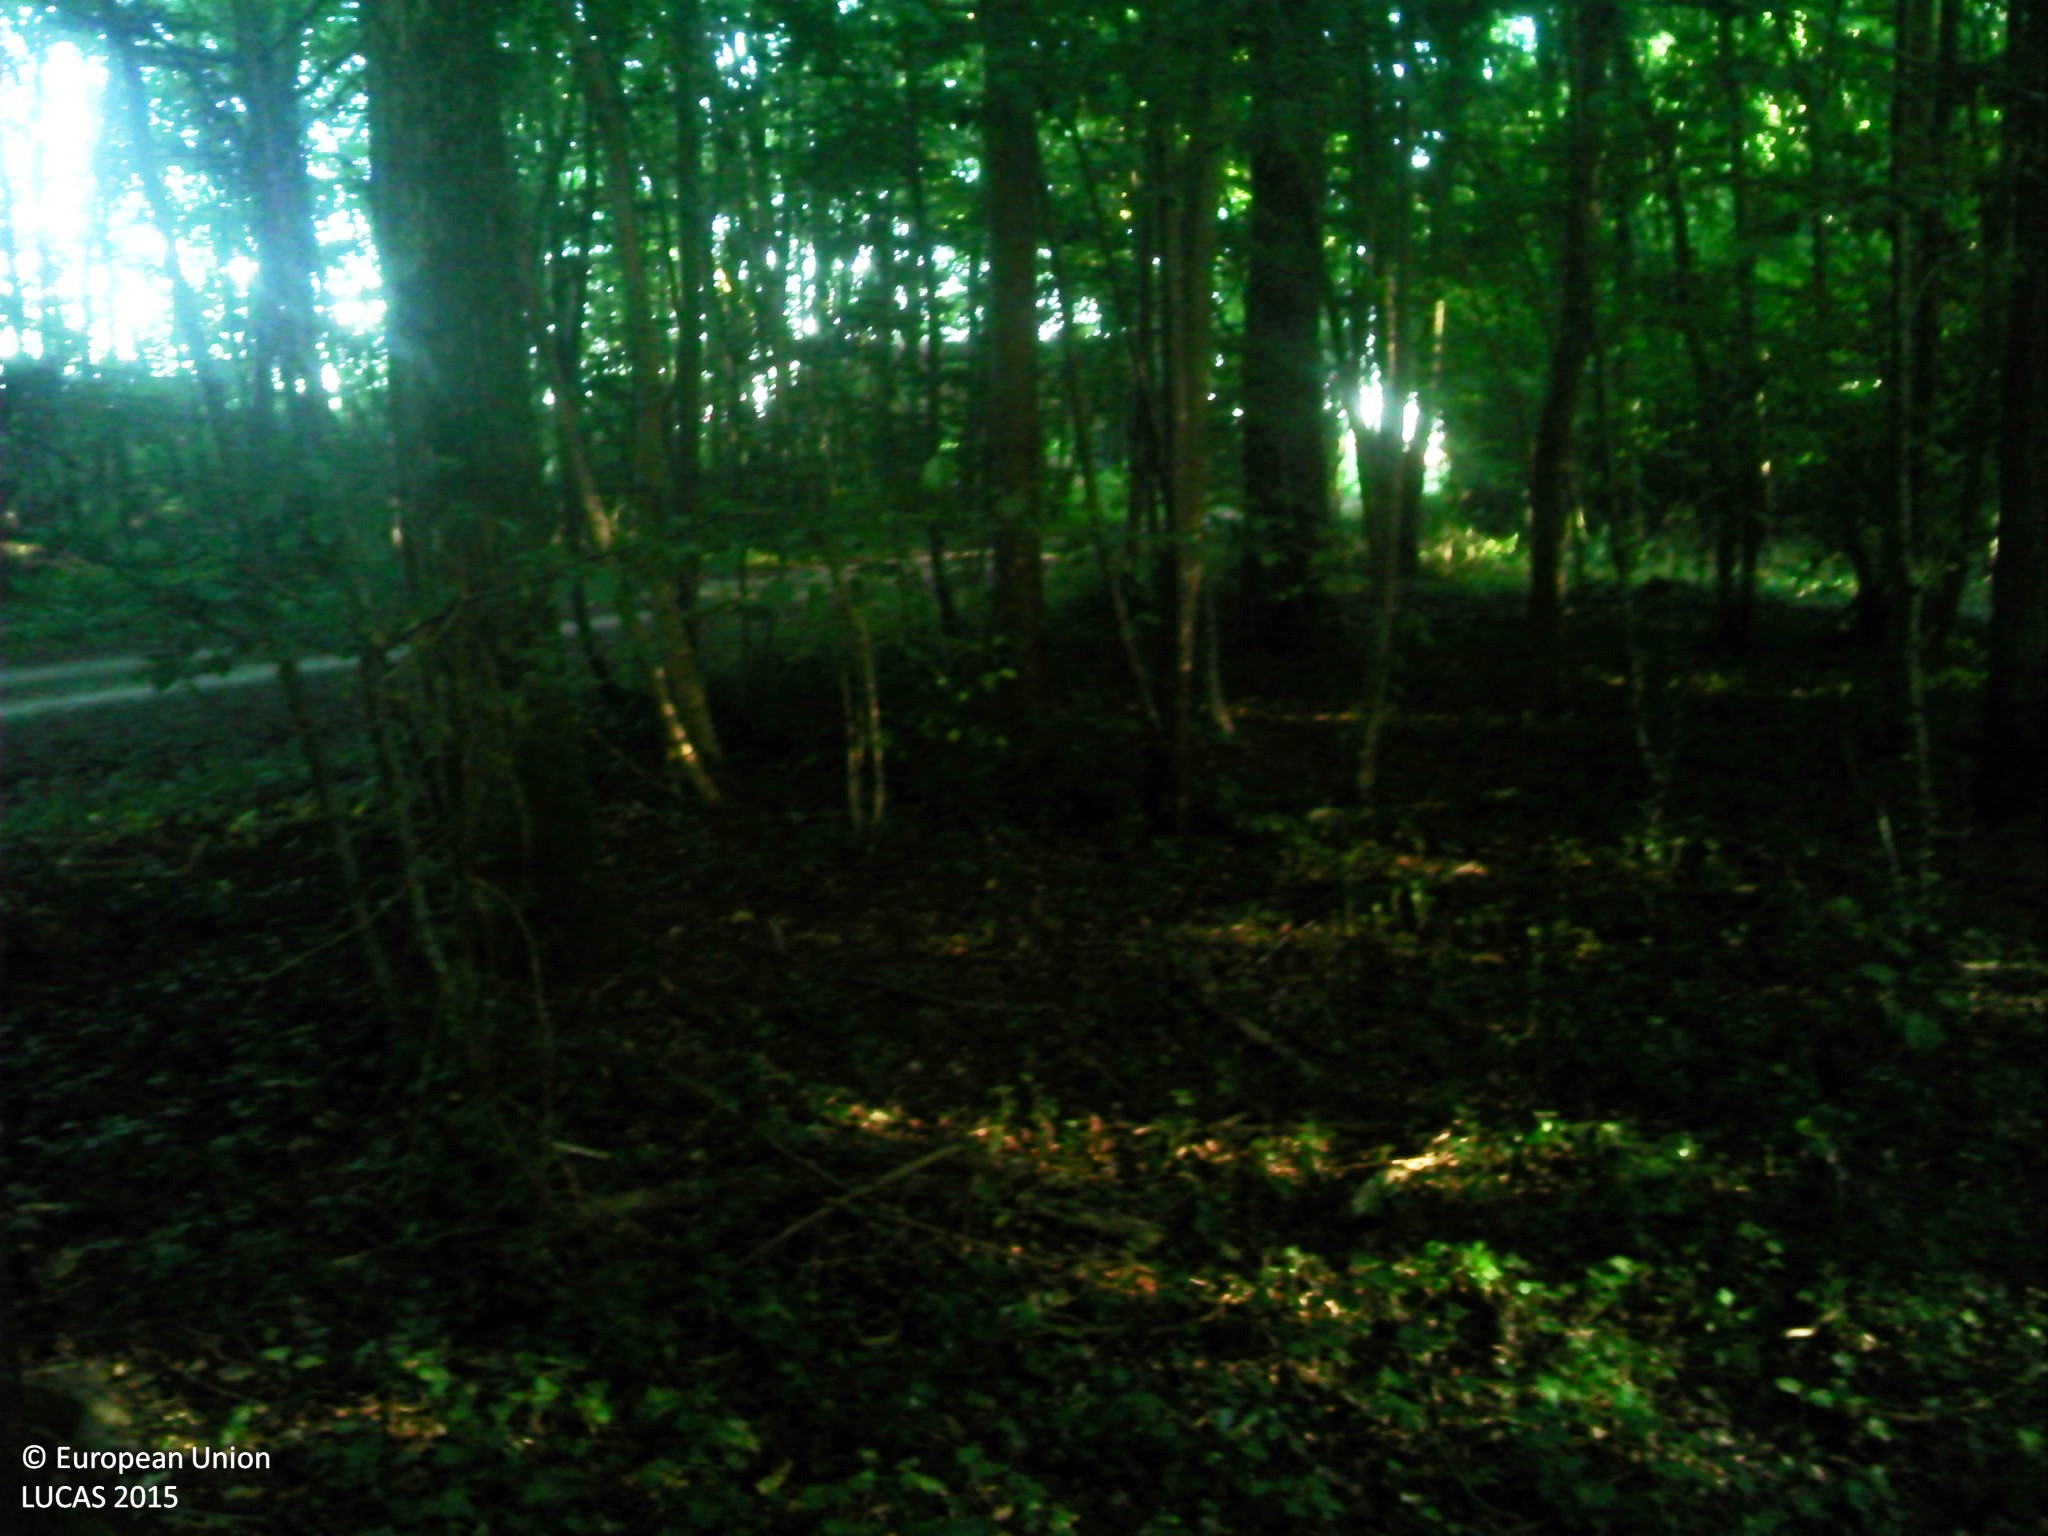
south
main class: Woodland
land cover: Broadleaved woodland
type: mesophytic deciduous forest
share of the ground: > 75 %
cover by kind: unconsolidated bare surface 60 %, broadleaved forest trees 20 %, herbaceous plants 20 %
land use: Forestry
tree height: > 5 m
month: June
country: FR
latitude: 47.2345
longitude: 1.3873
